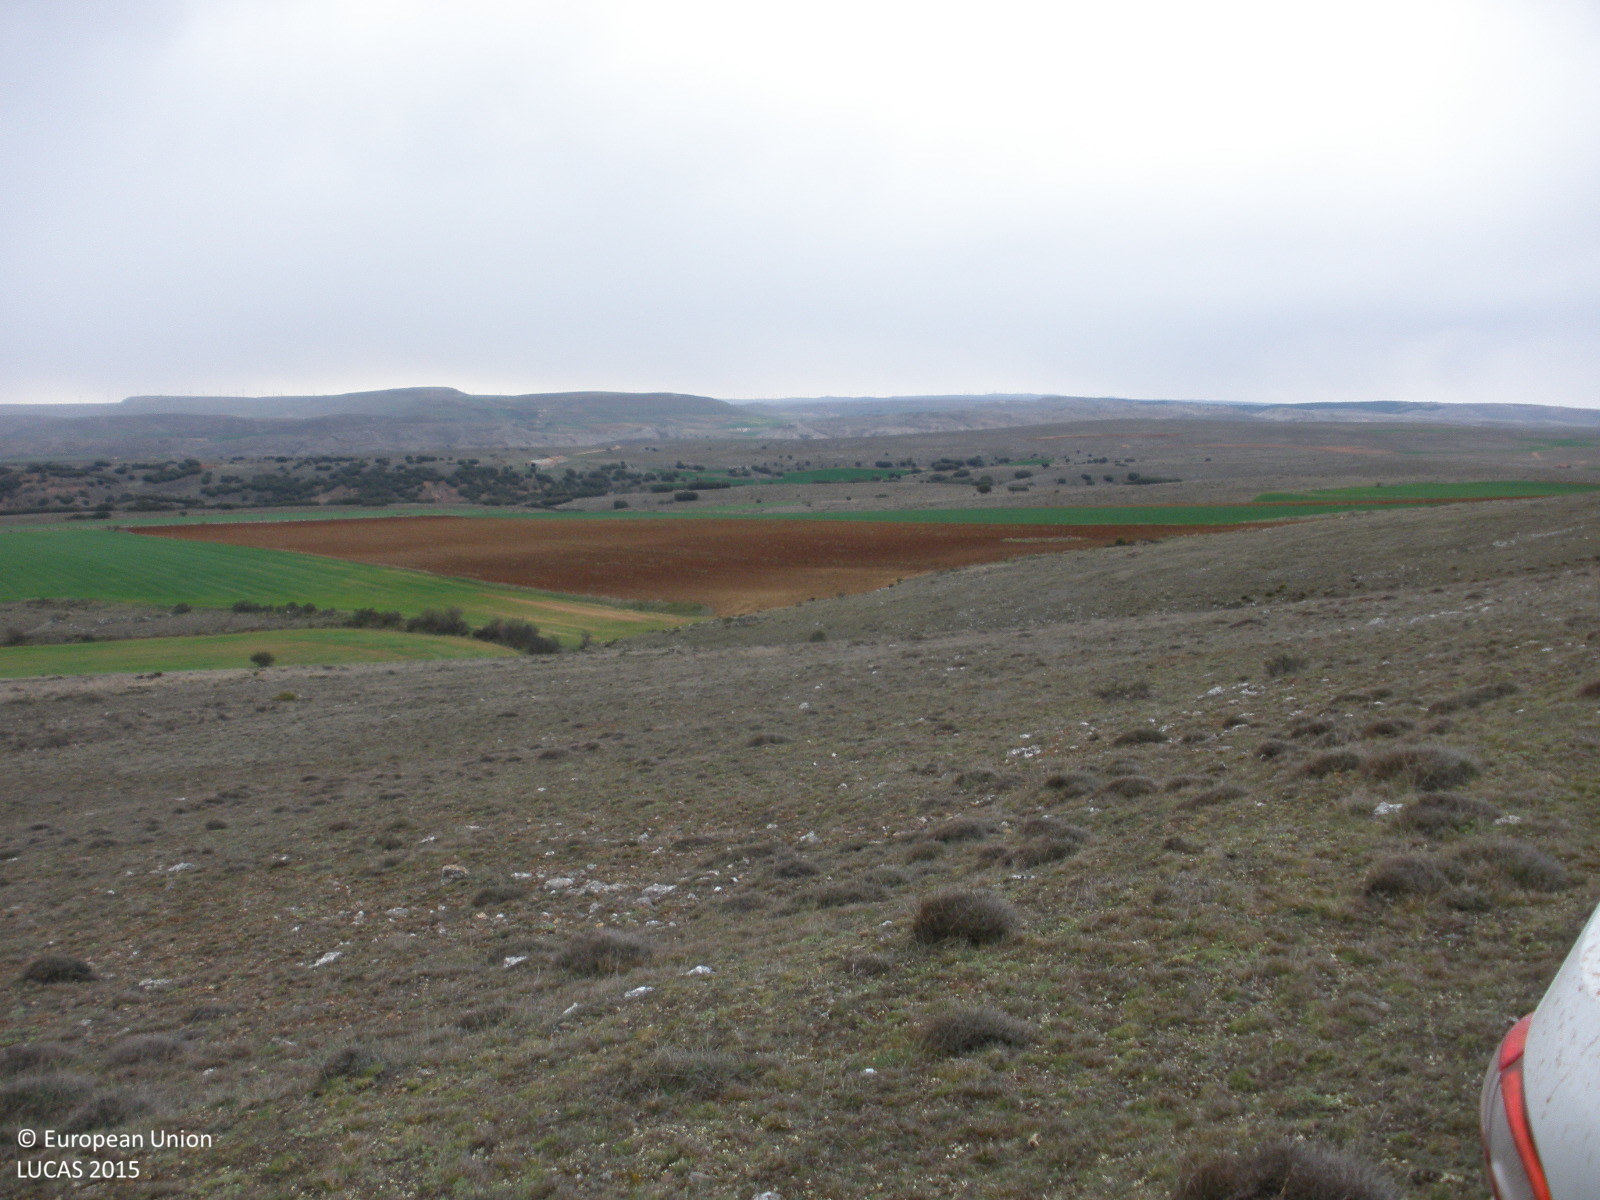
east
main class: Shrubland
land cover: Shrubland without tree cover
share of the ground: 25 - 50 %
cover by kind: herbaceous plants 50 %, shrubs 30 %, consolidated bare surface 20 %
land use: Semi-natural and natural areas not in use
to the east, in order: Shrubland without tree cover; Other bare soil
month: April
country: ES
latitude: 40.7494
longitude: -1.0886
